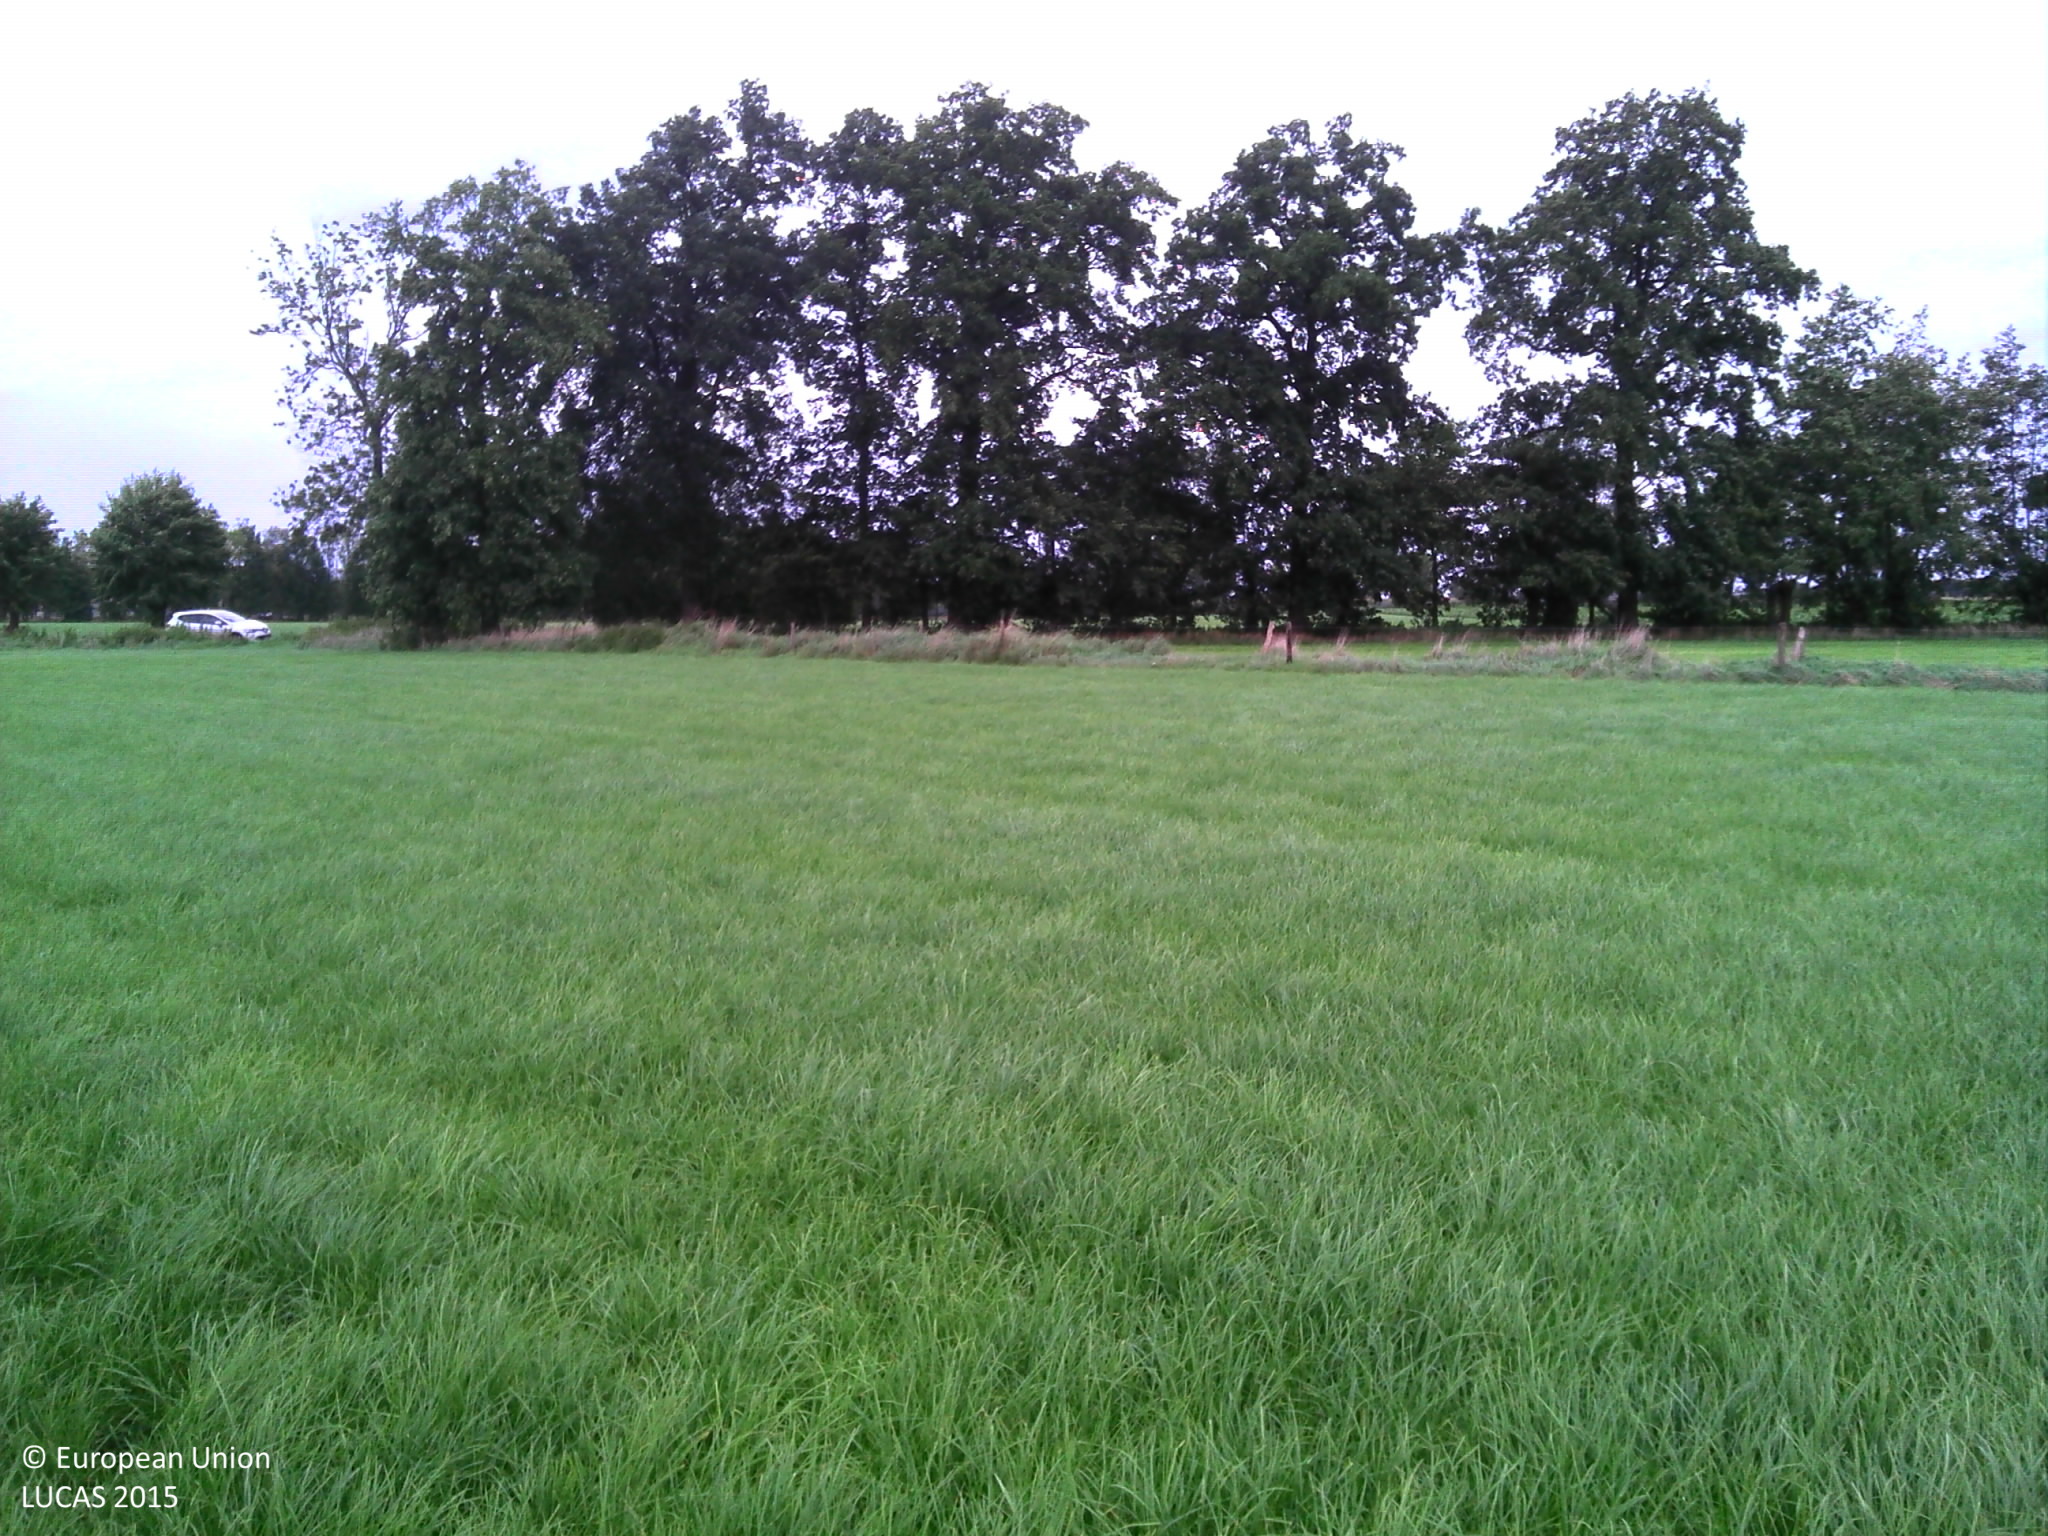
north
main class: Cropland
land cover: Temporary grasslands
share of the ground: > 75 %
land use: Agriculture (excluding fallow land and kitchen gardens)
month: September
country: BE
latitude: 51.3848
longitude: 4.4923
